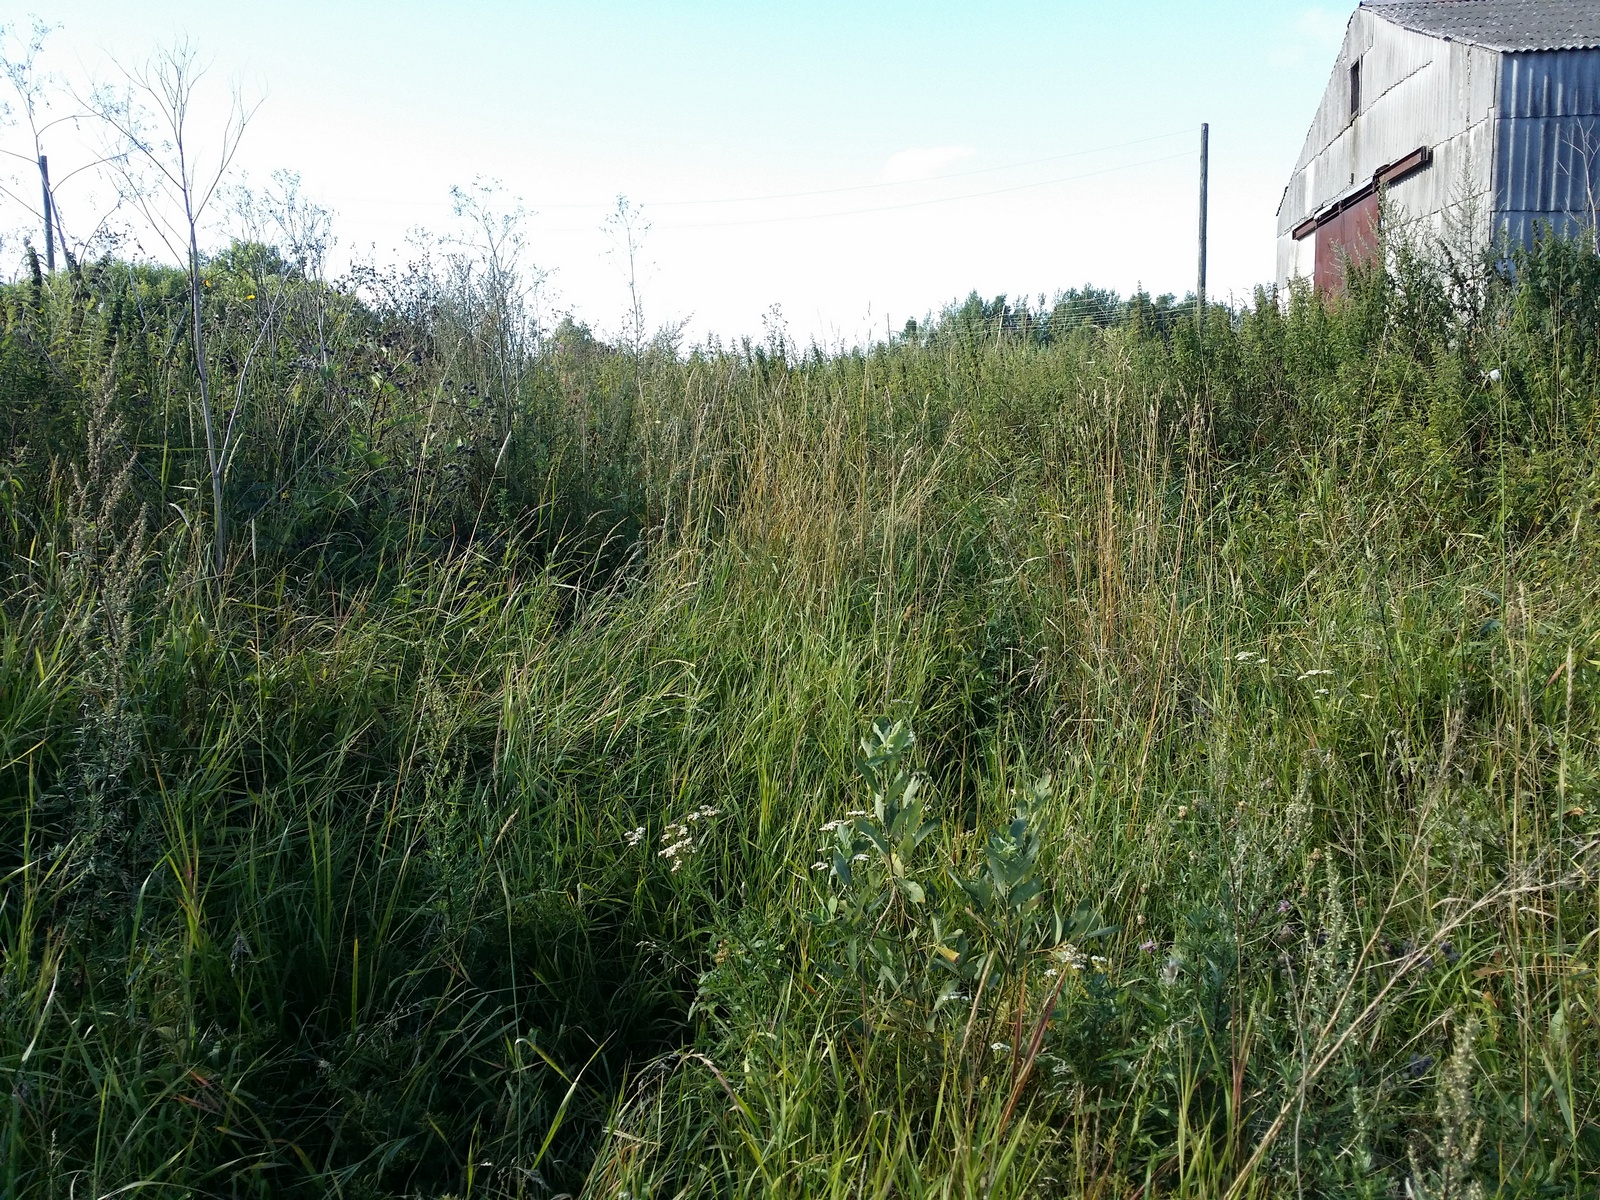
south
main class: Grassland
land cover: Spontaneously vegetated surfaces
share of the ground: > 75 %
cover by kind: herbaceous plants 100 %
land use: Semi-natural and natural areas not in use
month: August
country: LV
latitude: 57.1729
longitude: 27.7320
